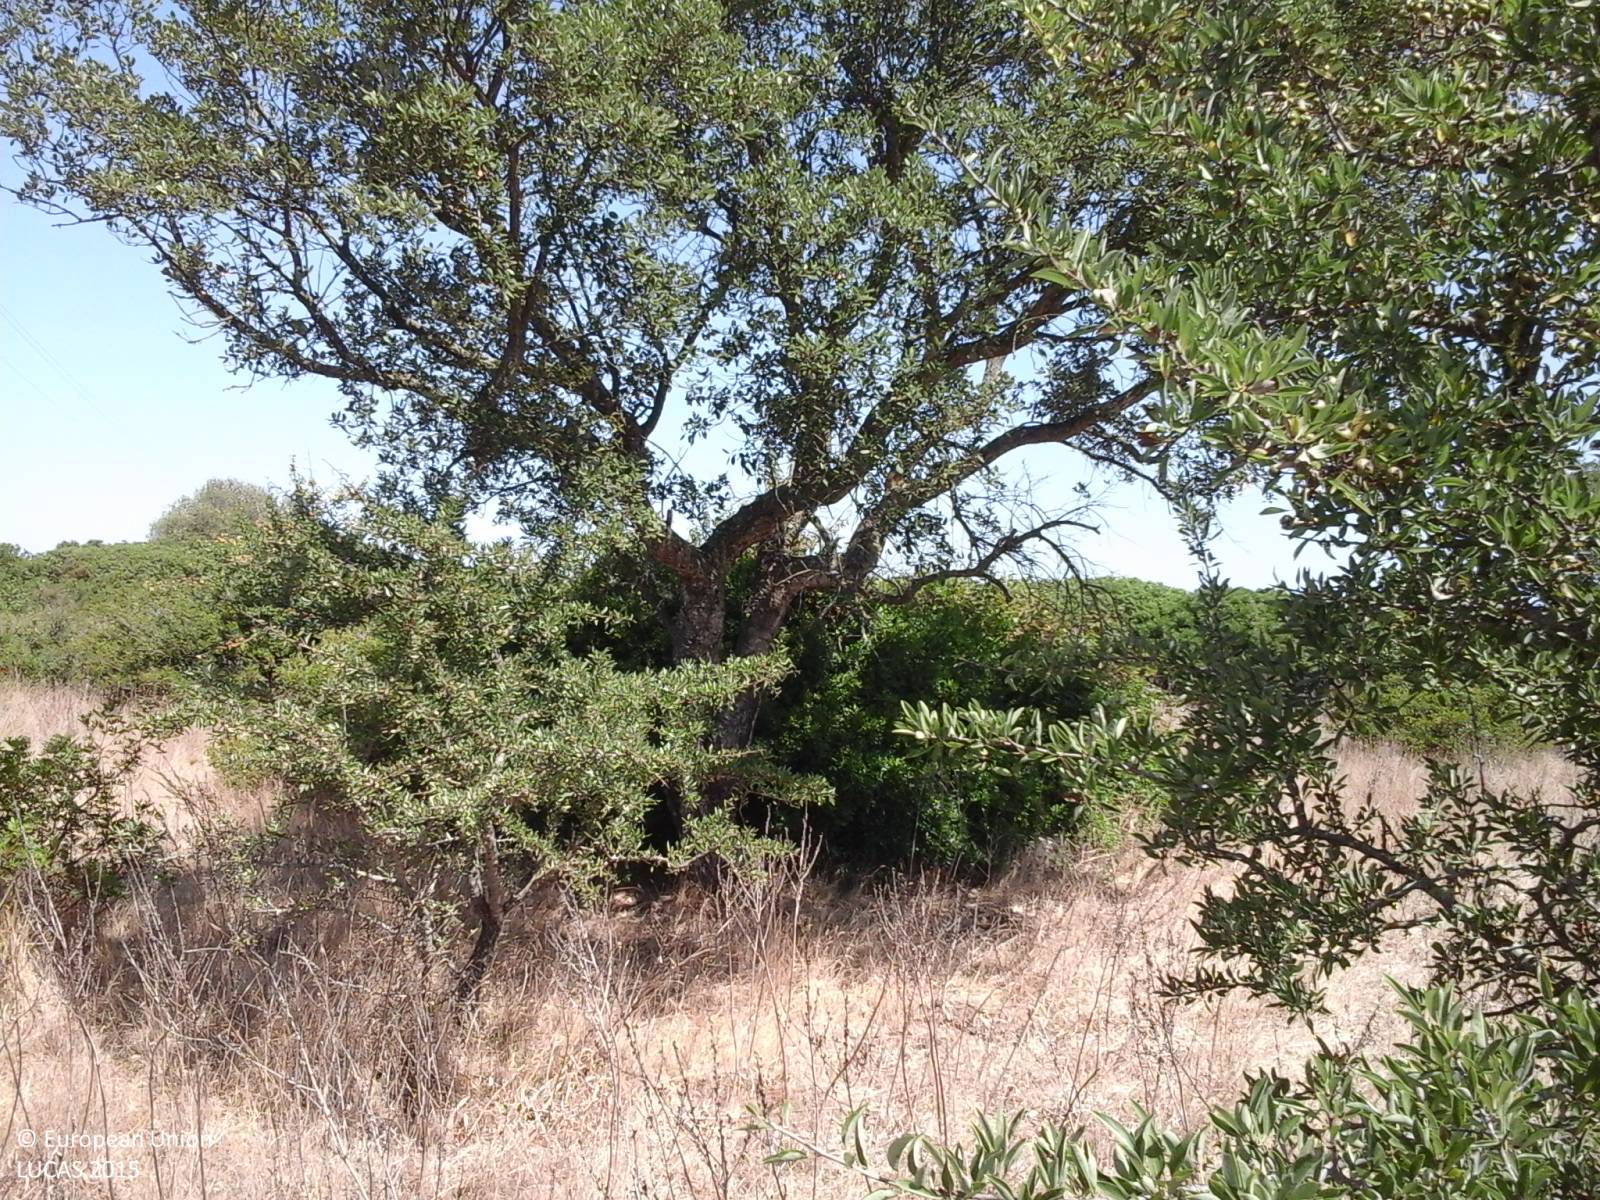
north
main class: Shrubland
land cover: Shrubland with sparse tree cover
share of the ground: > 75 %
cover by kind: shrubs 95 %, broadleaved forest trees 5 %
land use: Agriculture (excluding fallow land and kitchen gardens)
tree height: < 5 m
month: August
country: IT
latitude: 40.0614
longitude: 8.8456
